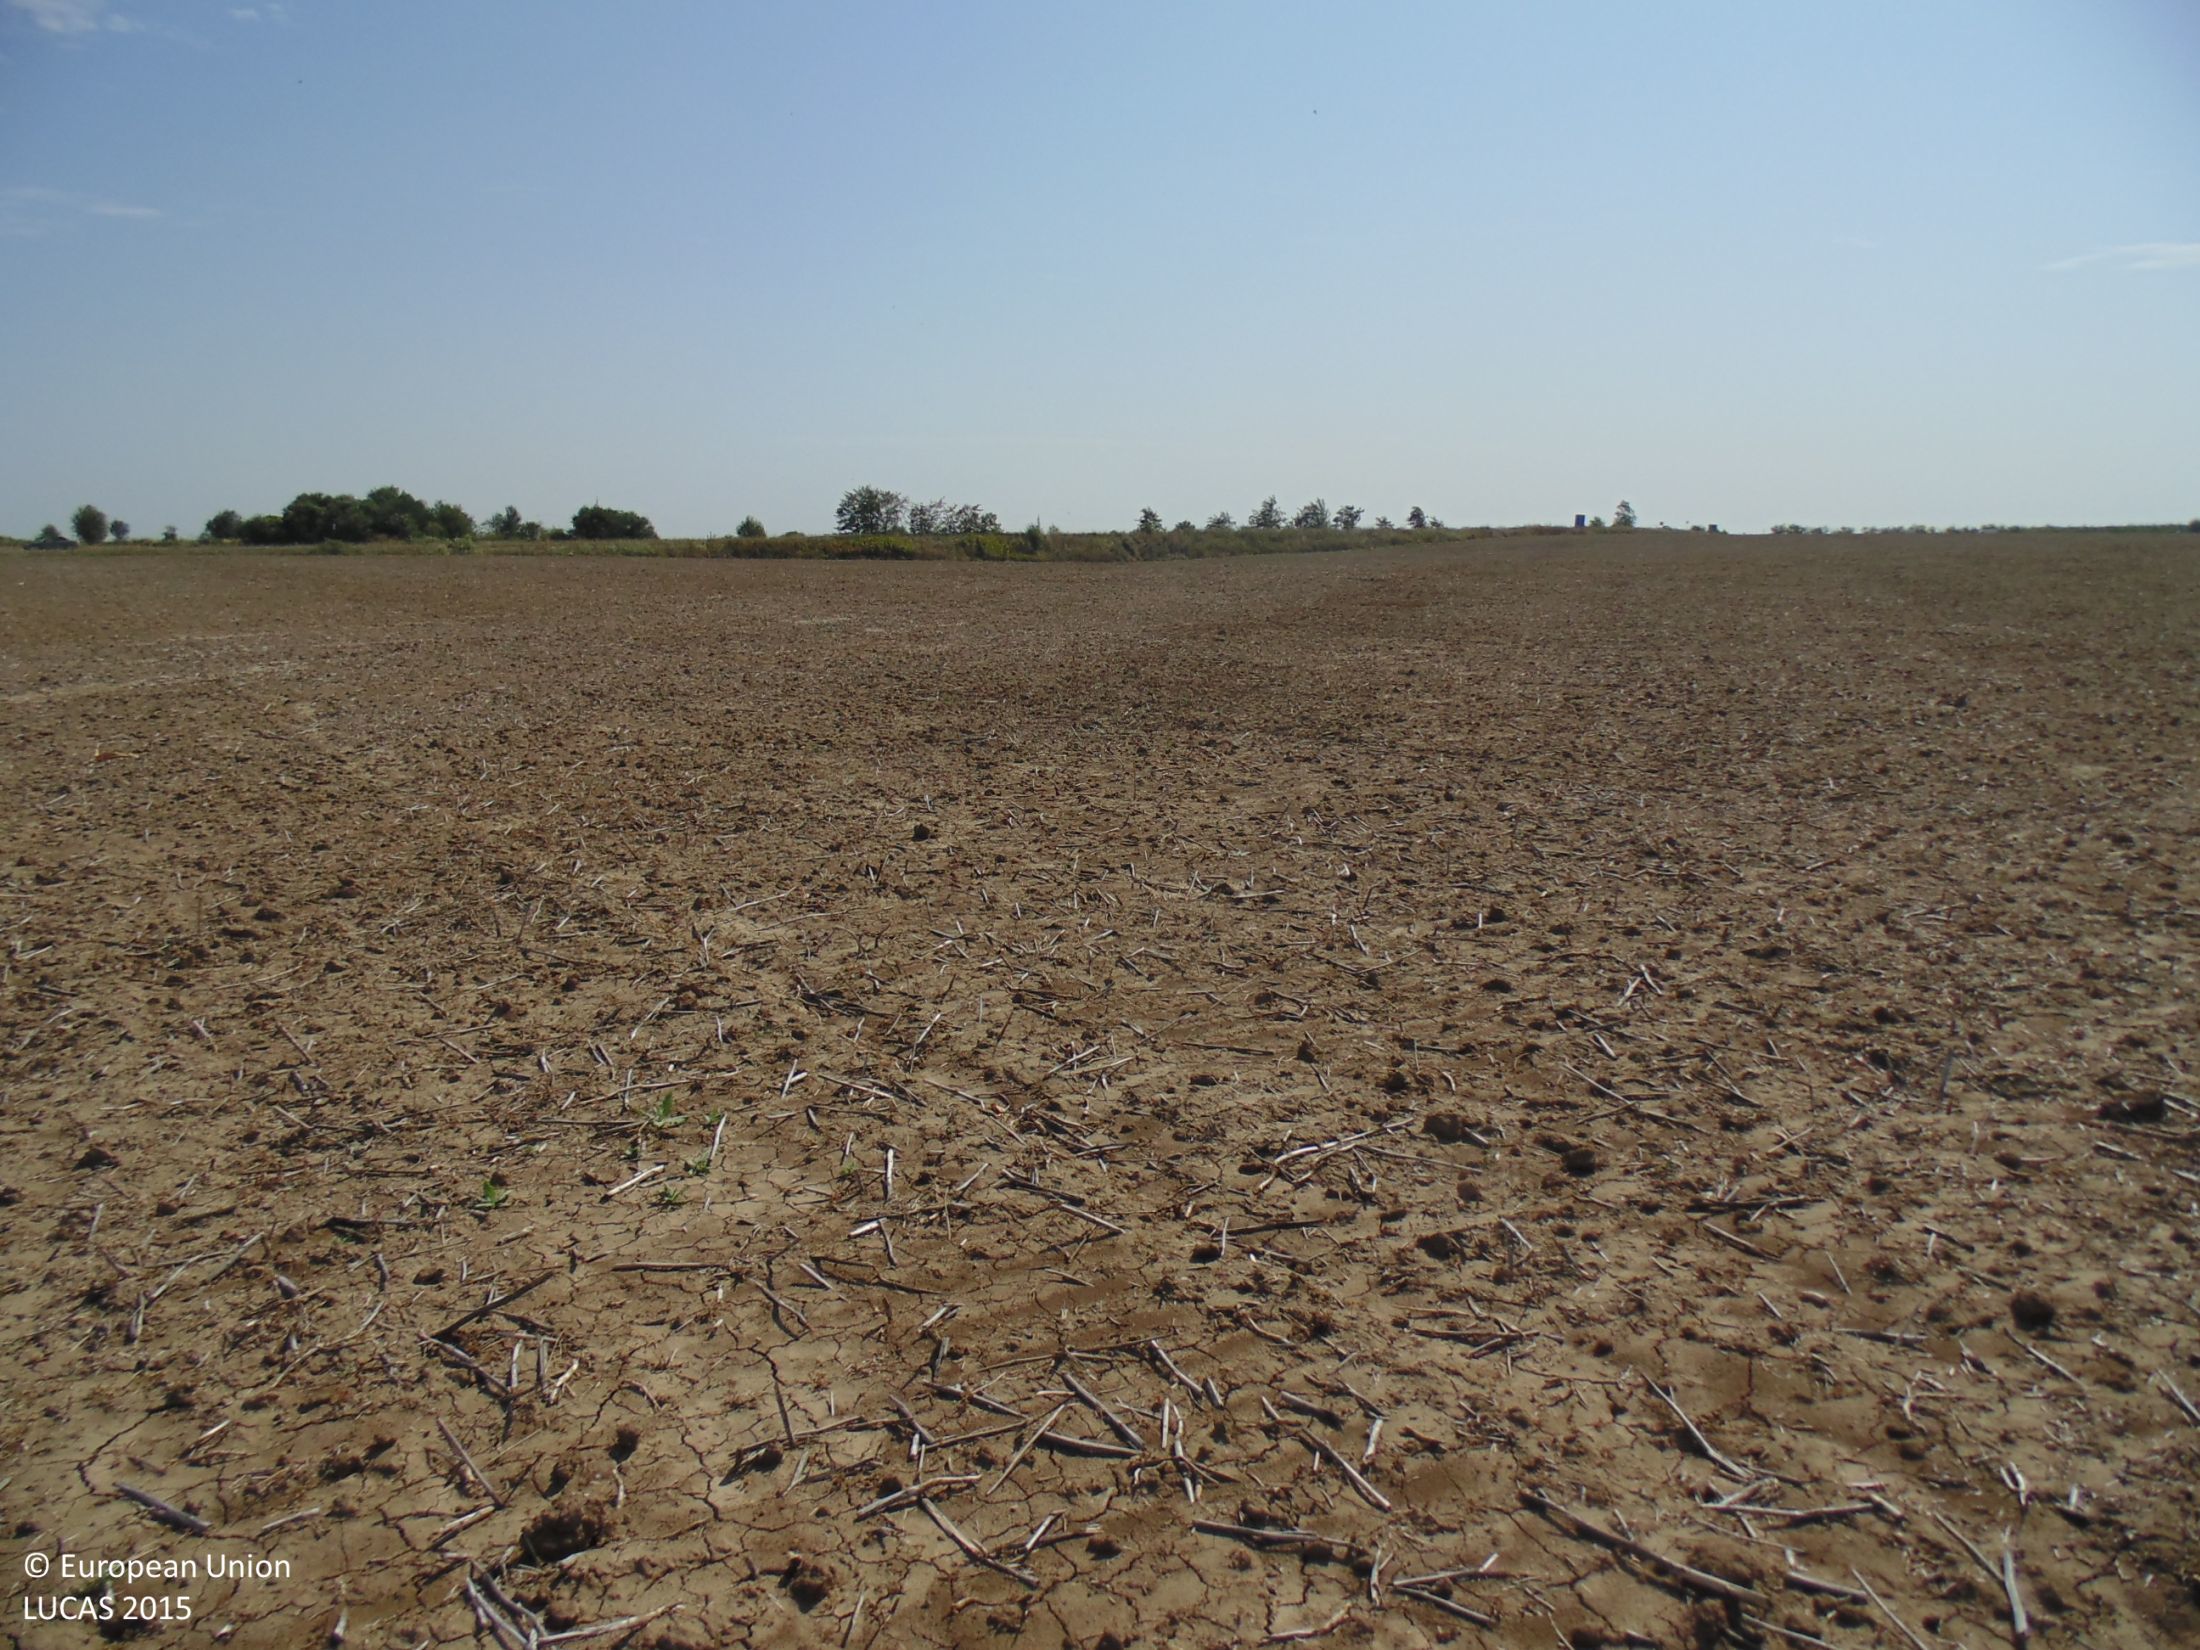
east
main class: Cropland
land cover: Rape and turnip rape
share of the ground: < 10 %
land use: Agriculture (excluding fallow land and kitchen gardens)
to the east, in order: Rape and turnip rape; Grass margins; Paved roads, cycling and walking lanes; Grass margins; Spontaneously vegetated surfaces
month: September
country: BG
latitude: 44.0793
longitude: 27.2001
